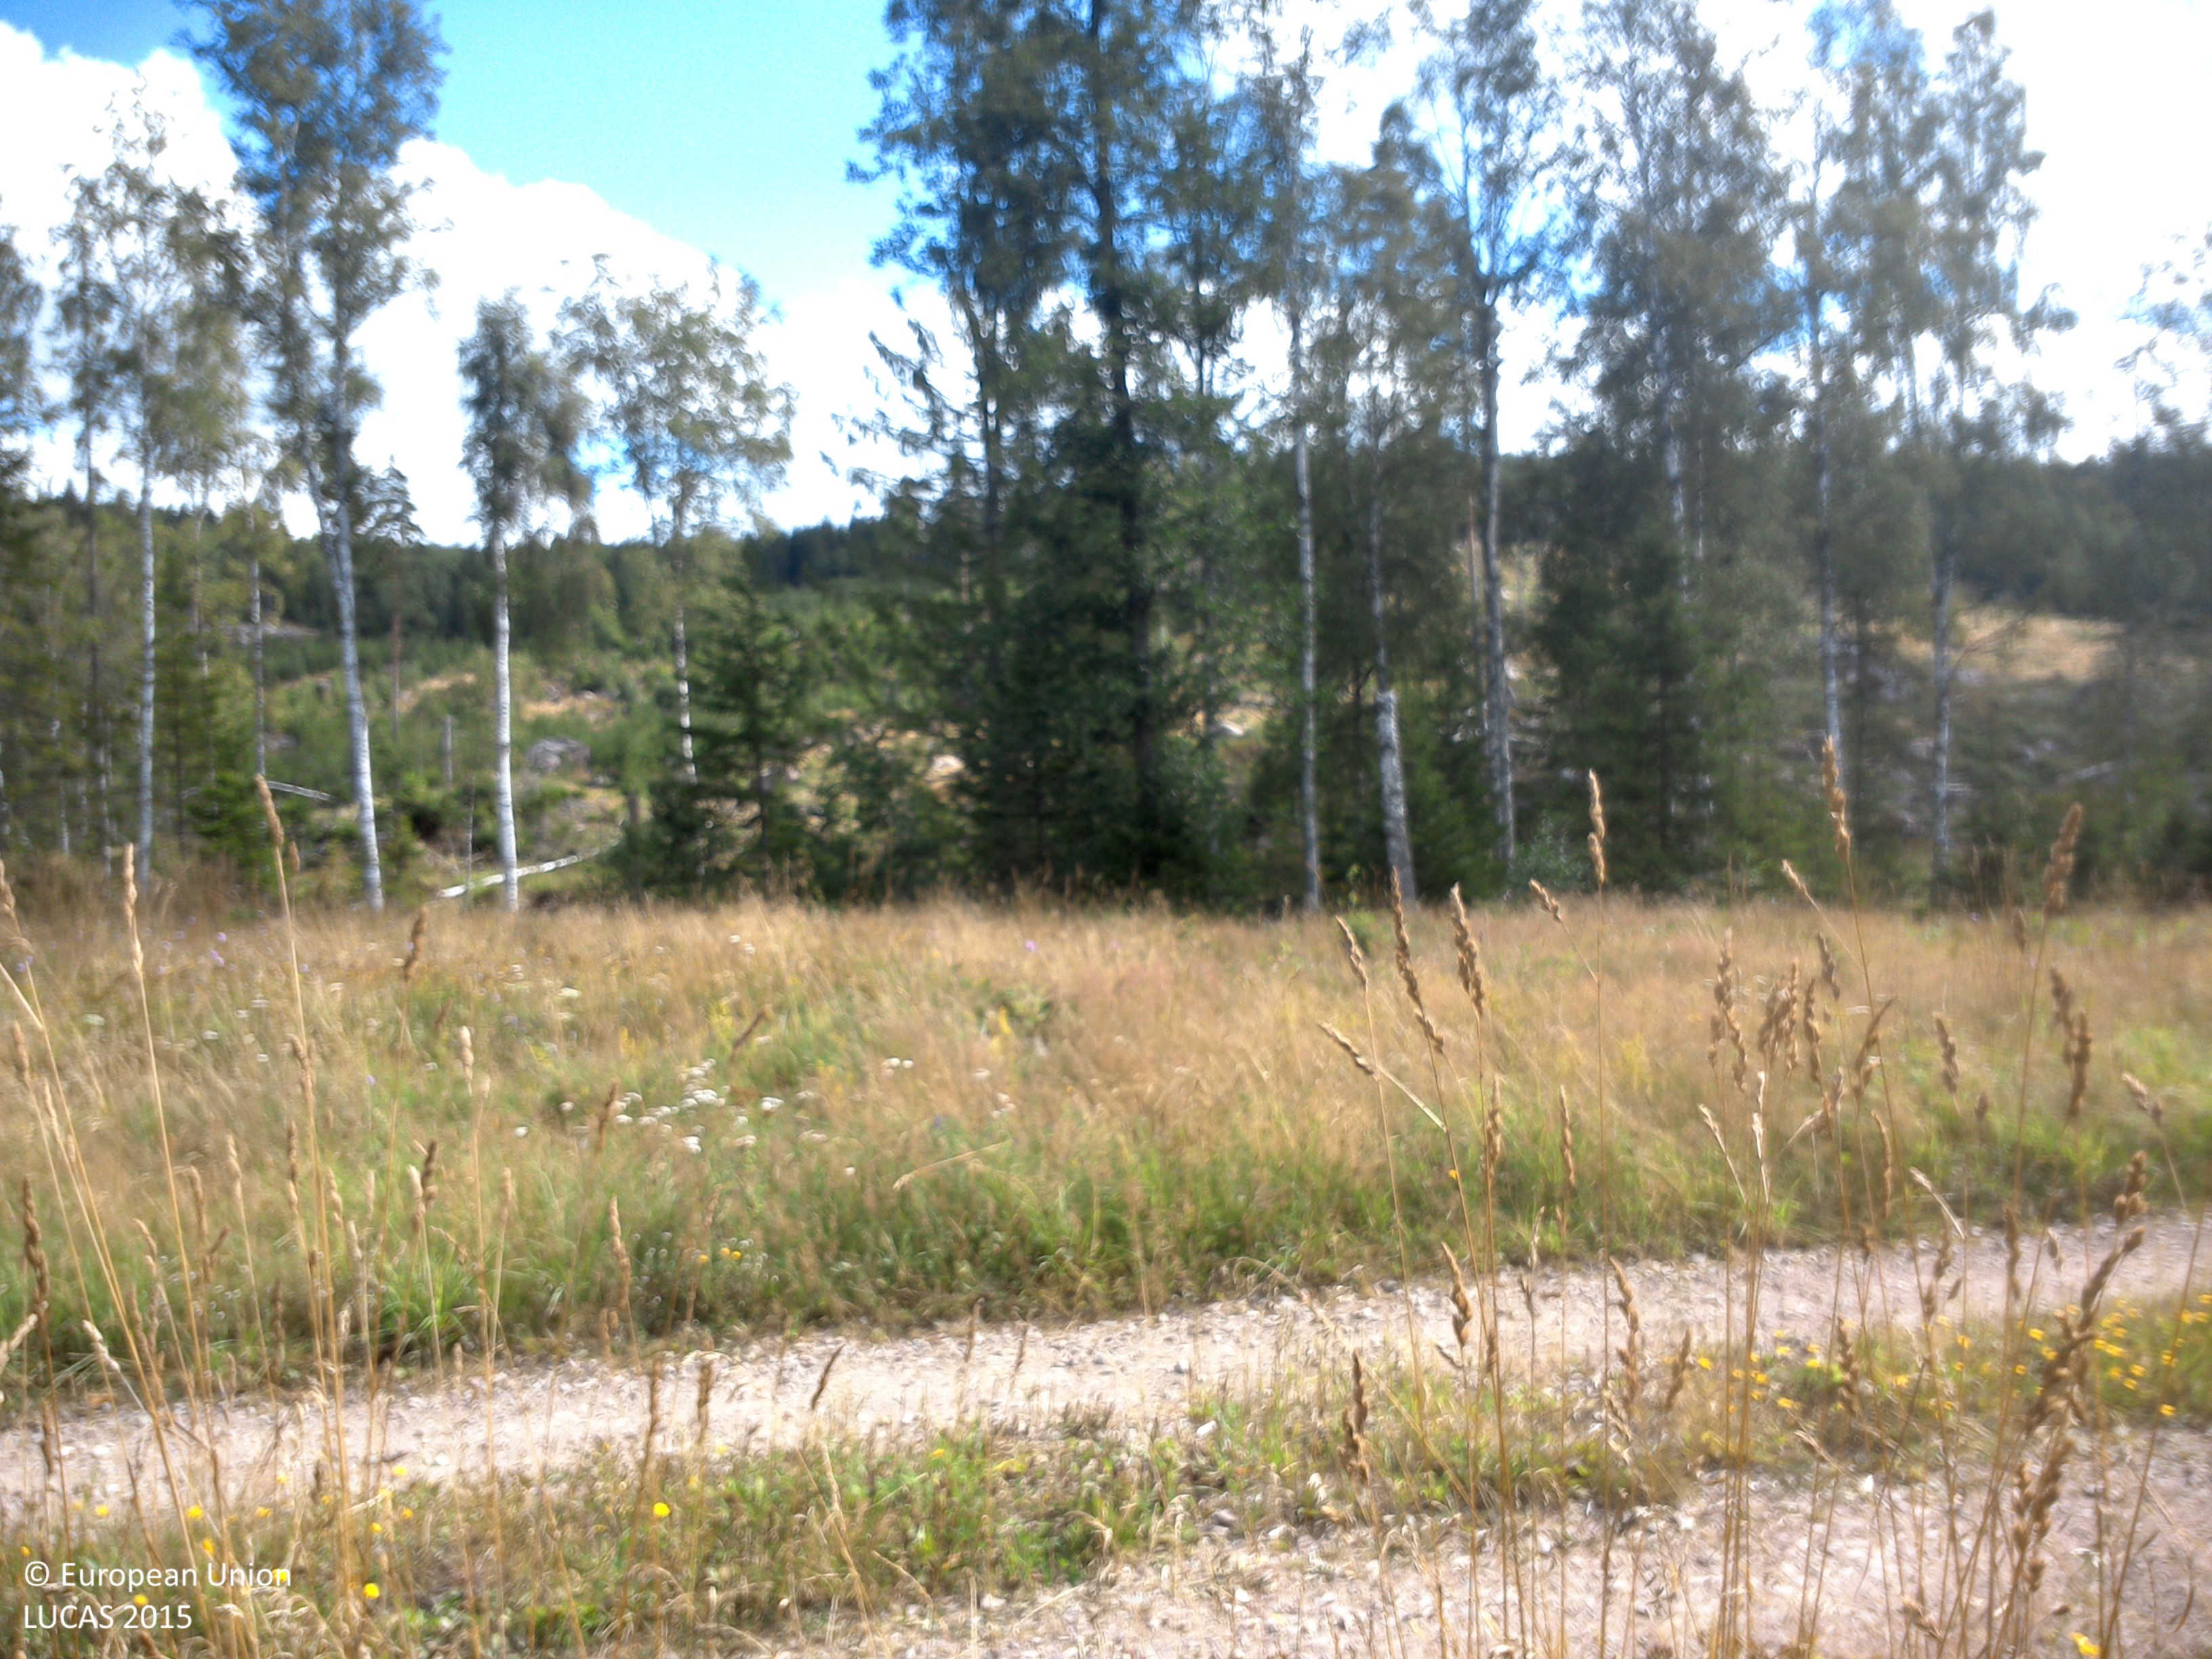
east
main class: Grassland
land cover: Grassland without tree/shrub cover
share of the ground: > 75 %
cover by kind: herbaceous plants 100 %
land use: Semi-natural and natural areas not in use
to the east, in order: Grassland without tree/shrub cover; Paved roads, cycling and walking lanes; Grassland with sparse tree/shrub cover; Spruce dominated mixed woodland; Ditches and canals; Spruce dominated mixed woodland; Grassland without tree/shrub cover; Spruce dominated mixed woodland
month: August
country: SE
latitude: 58.0762
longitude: 15.3700
